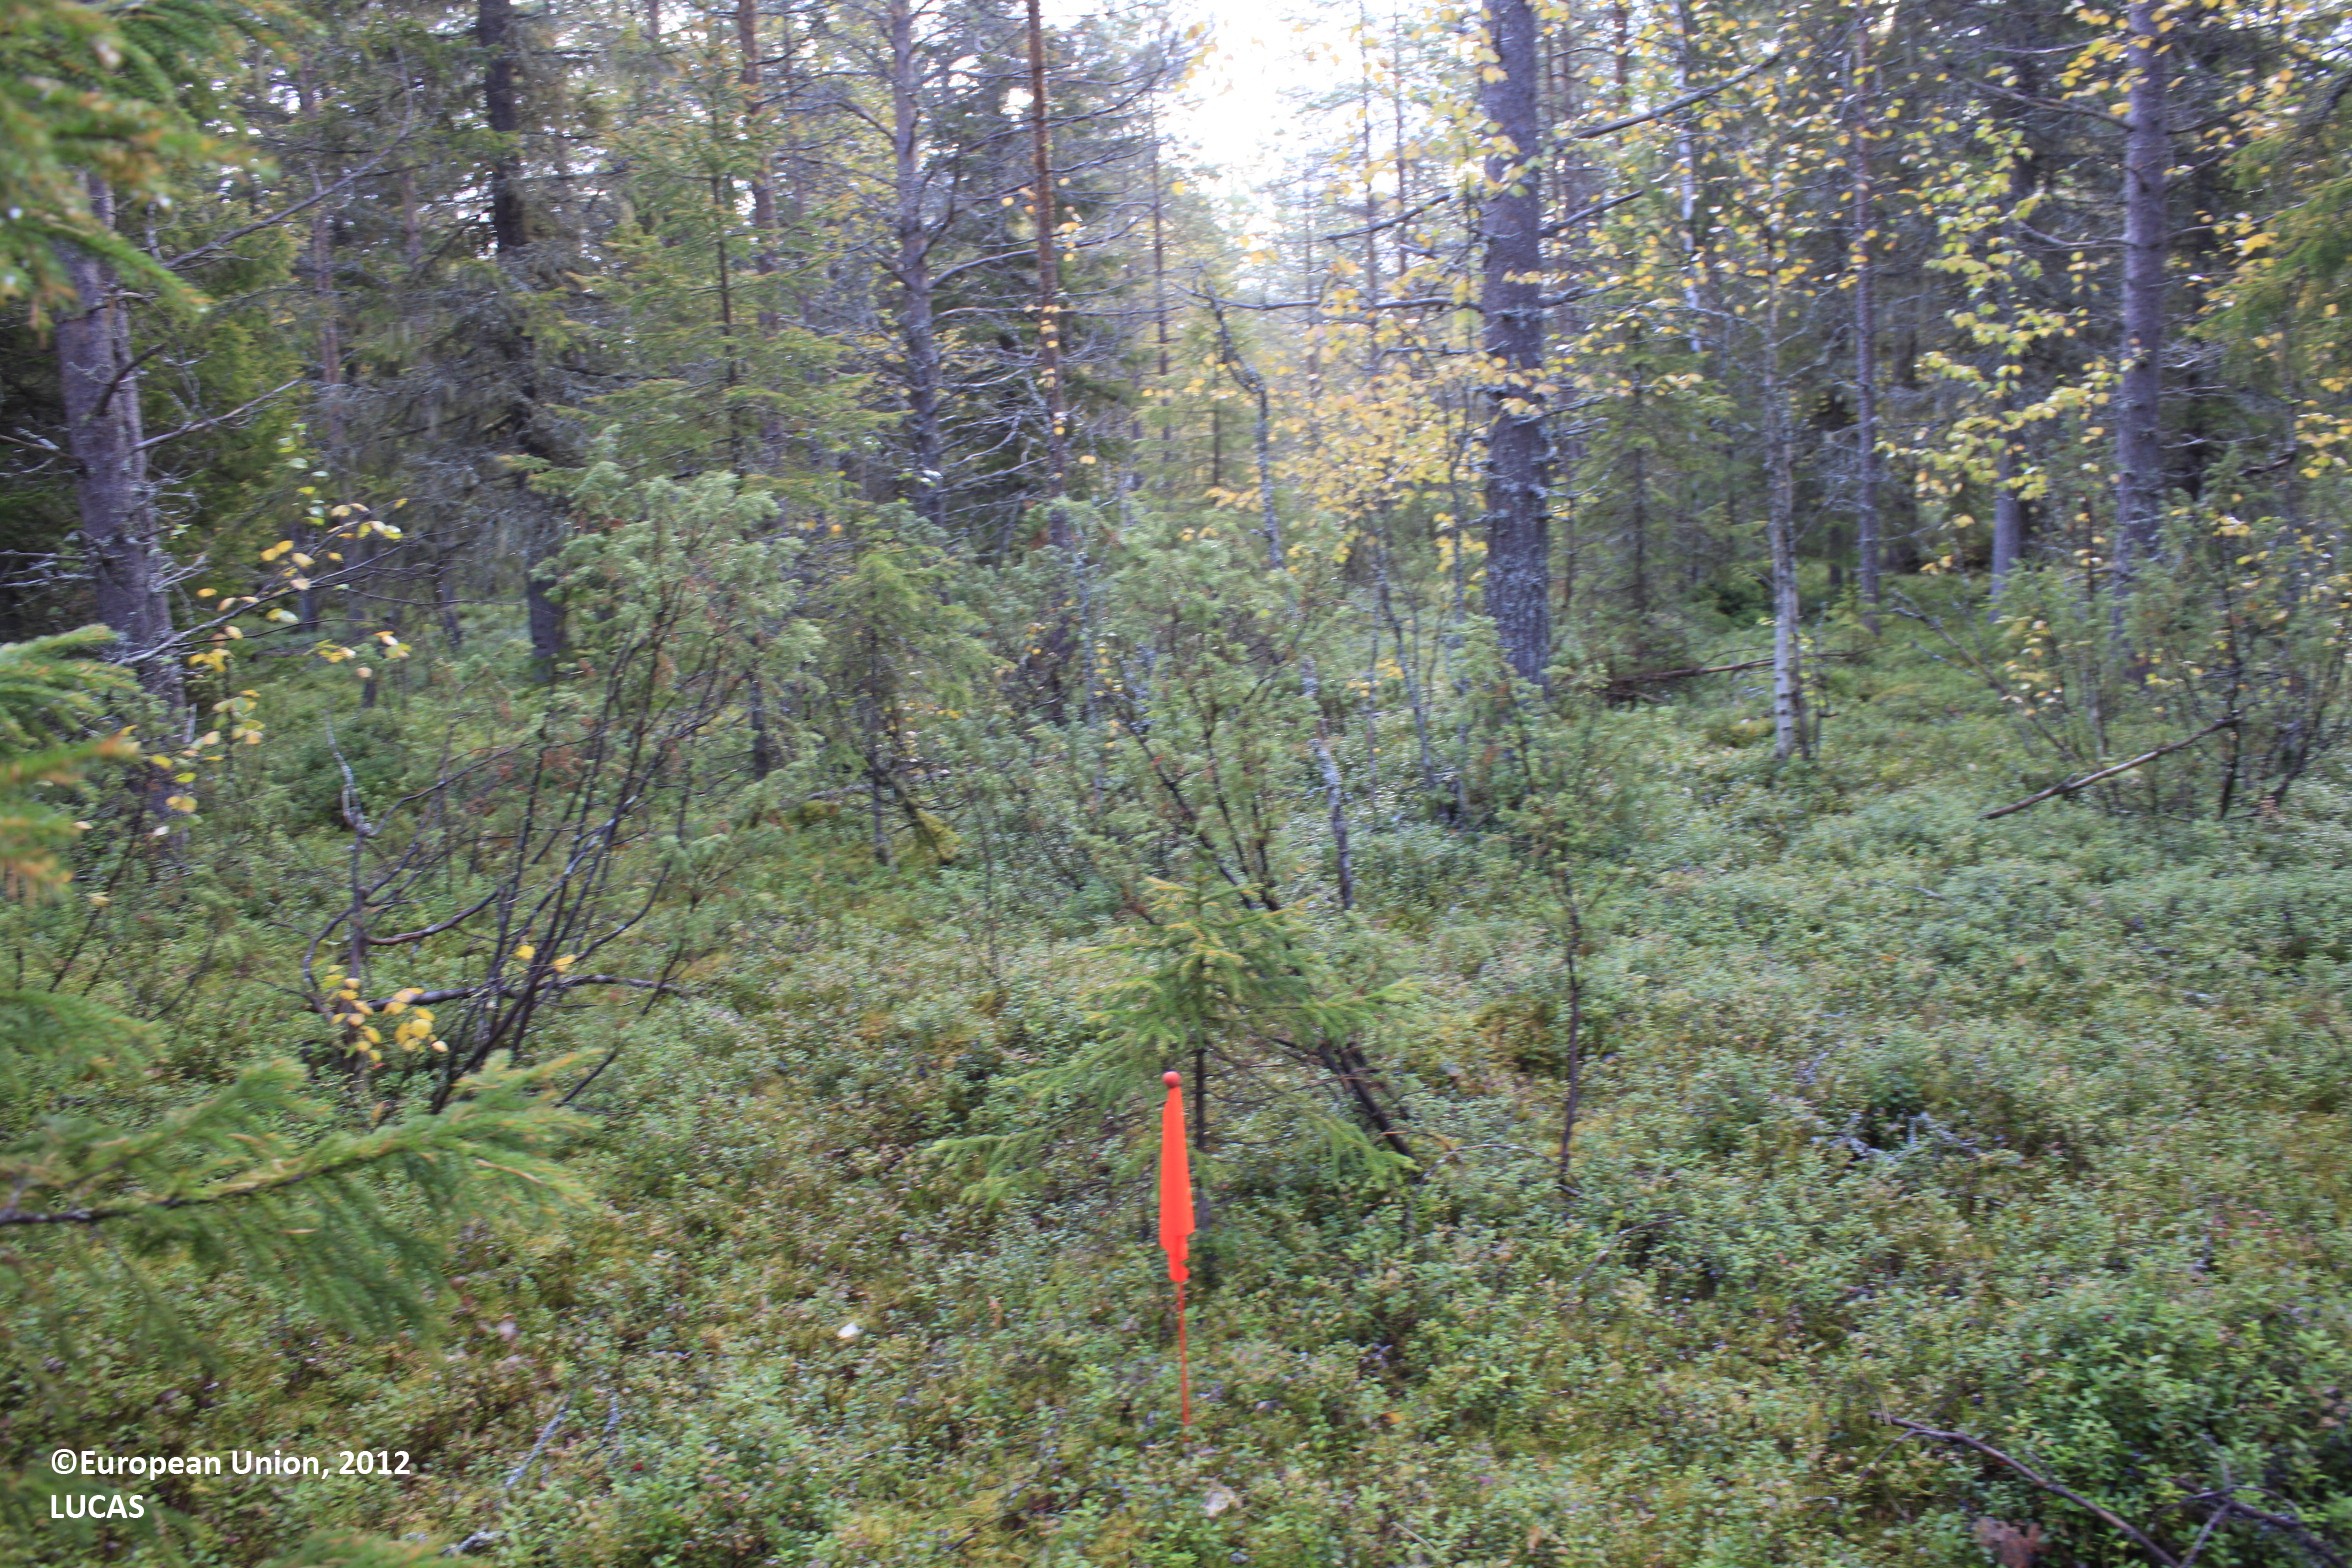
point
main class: Woodland
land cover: Pine dominated mixed woodland
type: boreal forest
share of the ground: 25 - 50 %
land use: Forestry
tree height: > 5 m
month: September
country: FI
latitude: 65.6367
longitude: 26.7249
